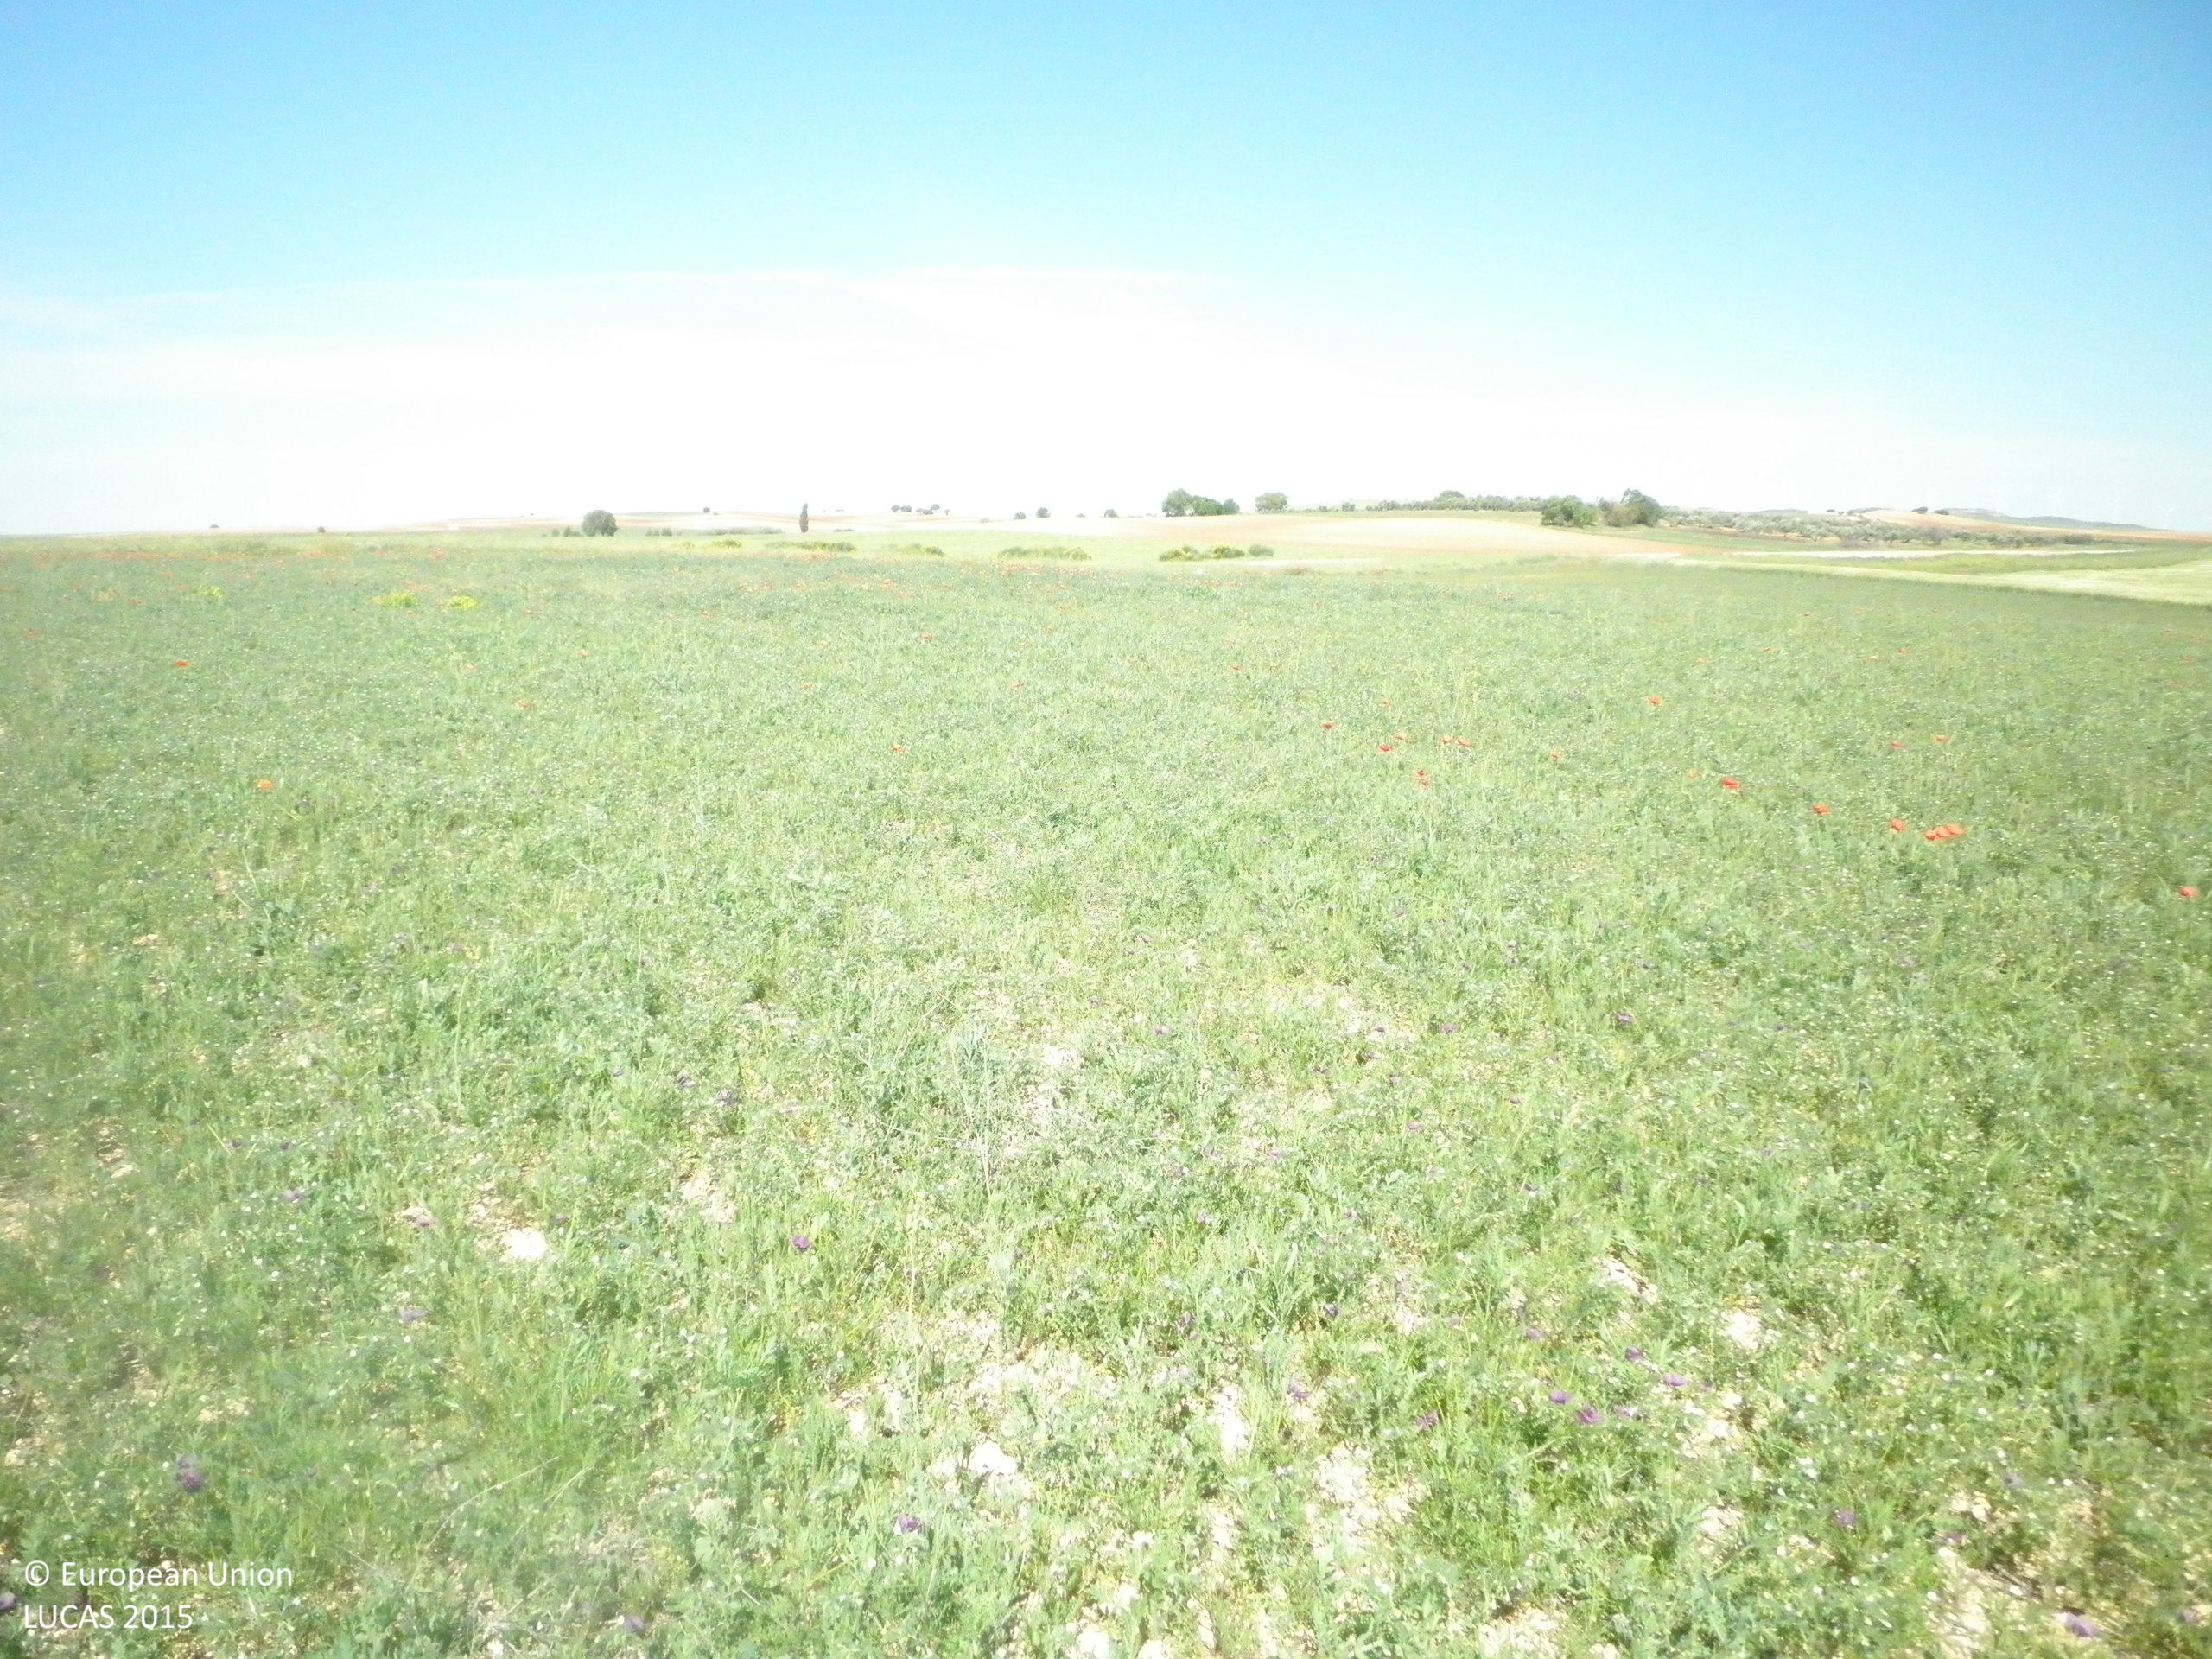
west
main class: Cropland
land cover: Dry pulses
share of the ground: > 75 %
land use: Agriculture (excluding fallow land and kitchen gardens)
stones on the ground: 10 - 25 %
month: May
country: ES
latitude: 39.7220
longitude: -2.7686
